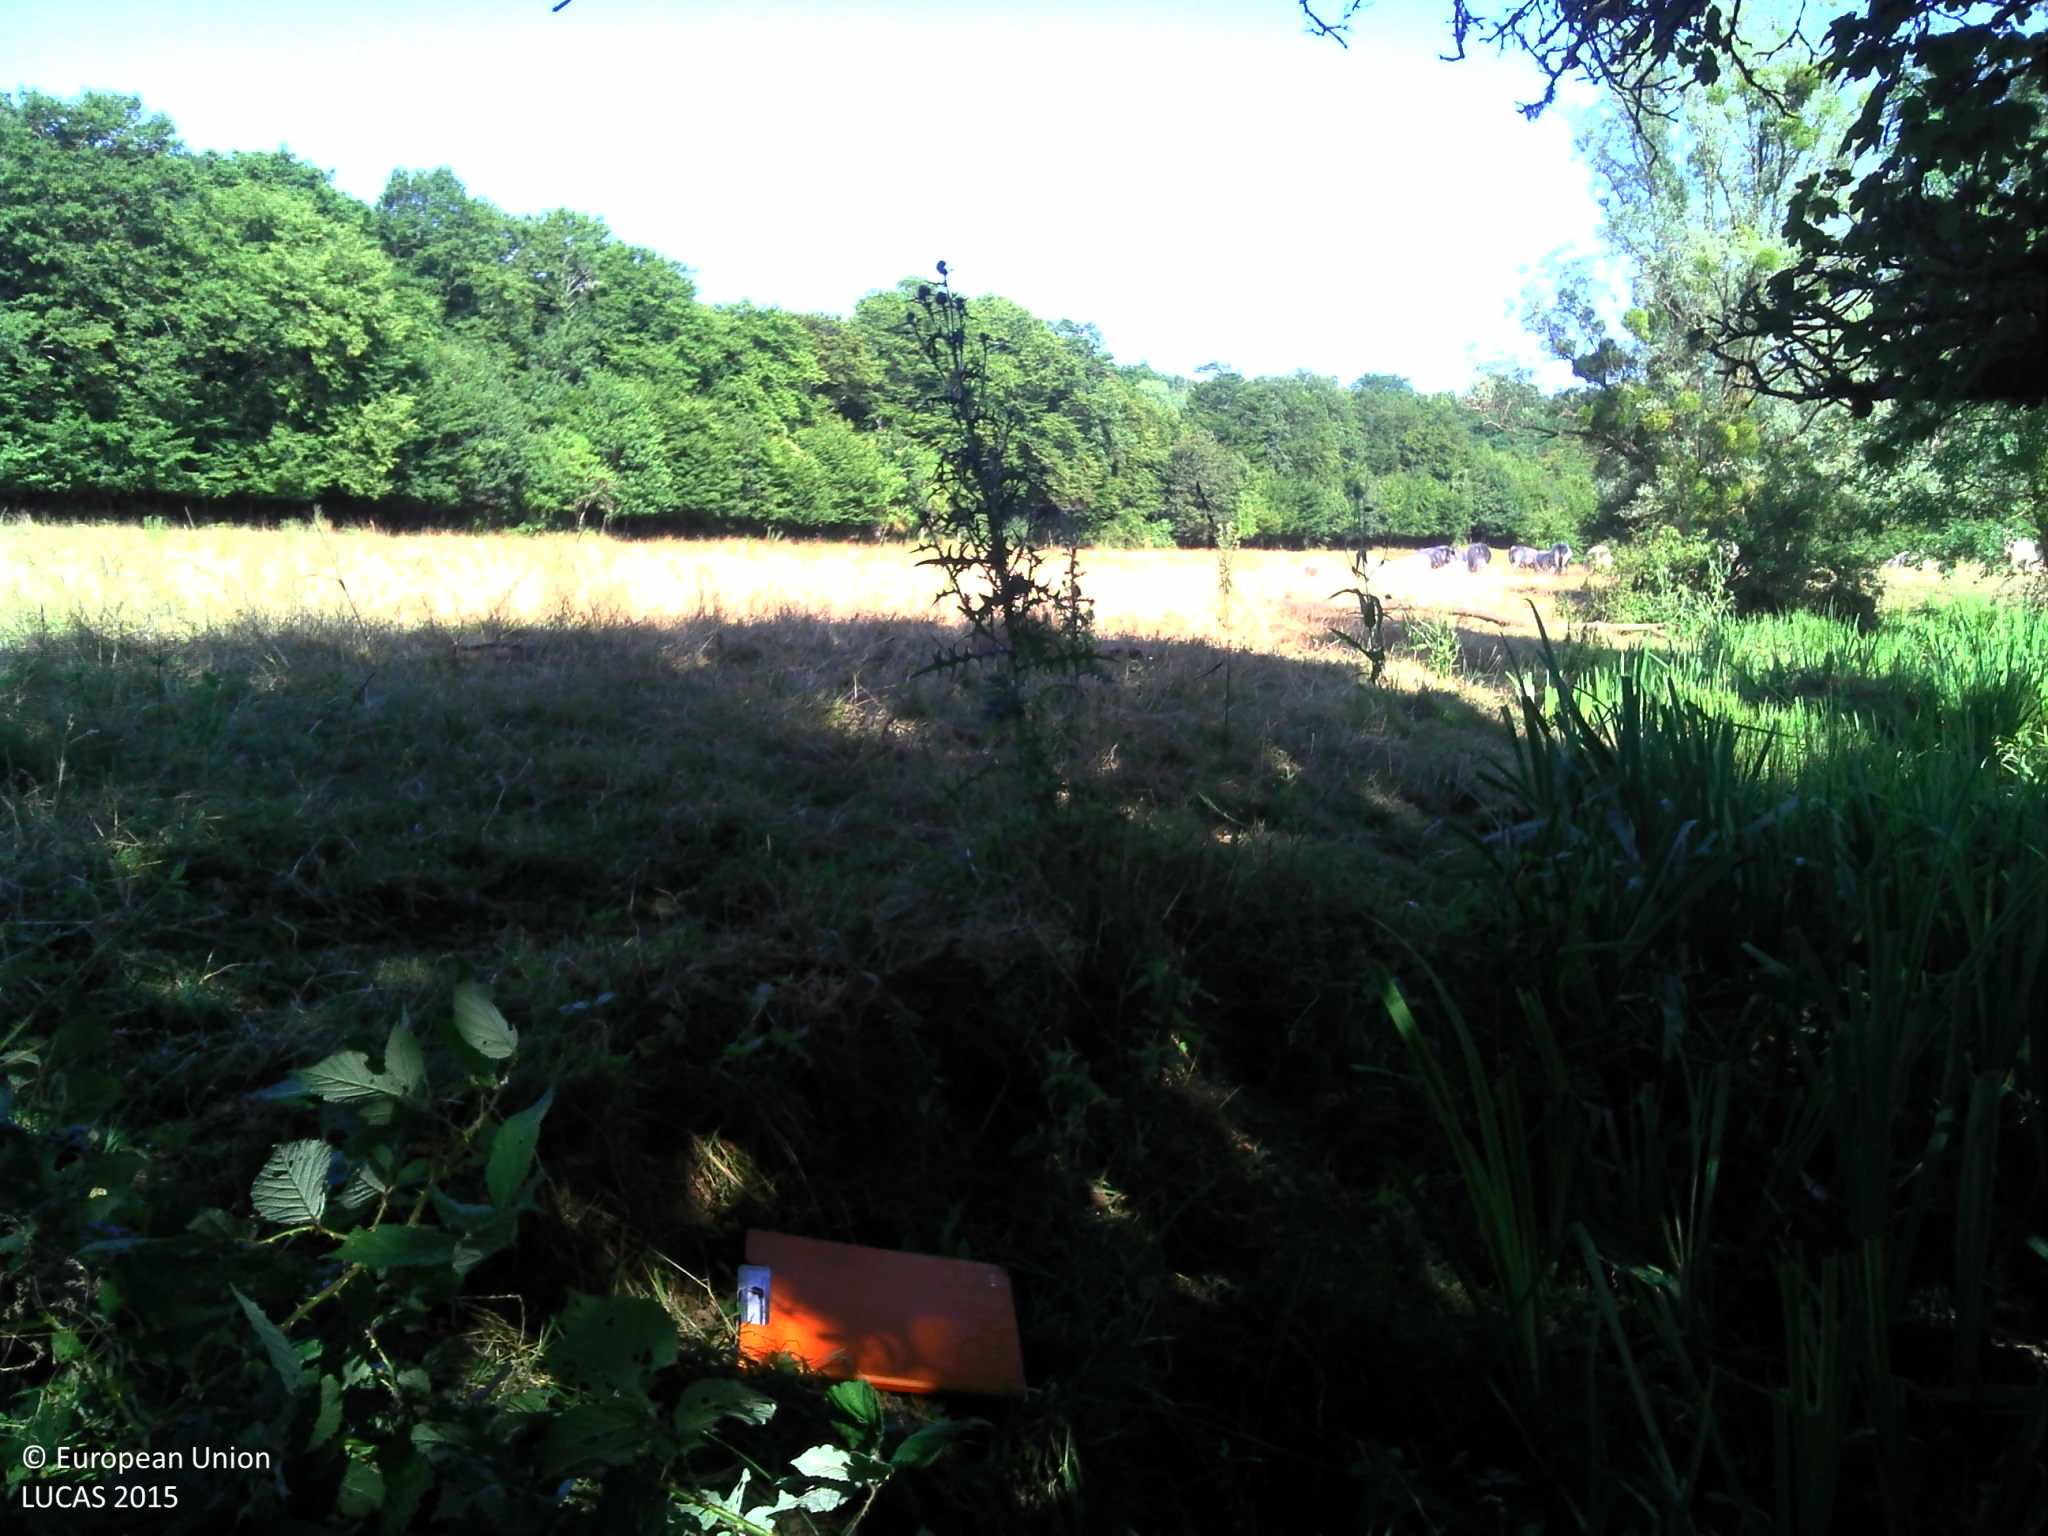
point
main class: Grassland
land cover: Grassland without tree/shrub cover
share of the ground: > 75 %
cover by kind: herbaceous plants 100 %
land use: Agriculture (excluding fallow land and kitchen gardens)
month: July
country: FR
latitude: 46.9900
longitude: 3.5944
